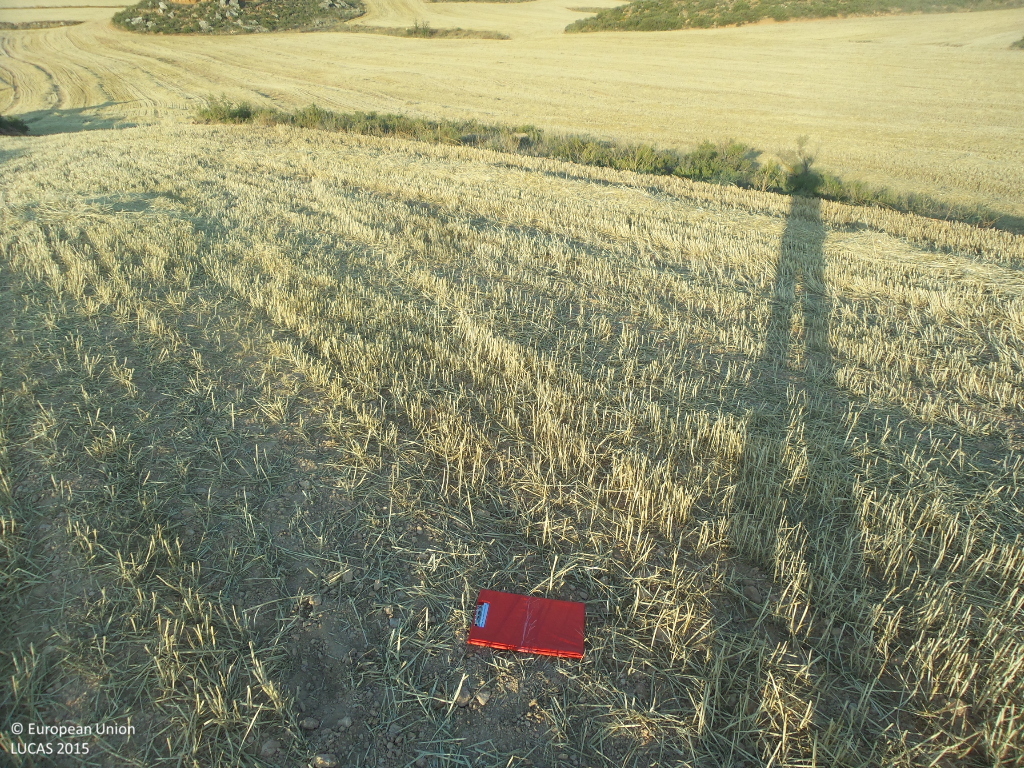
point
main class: Cropland
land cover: Barley
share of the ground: < 10 %
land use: Agriculture (excluding fallow land and kitchen gardens)
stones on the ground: < 10 %
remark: Harvested field
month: July
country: ES
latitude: 41.2812
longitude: -2.1479
